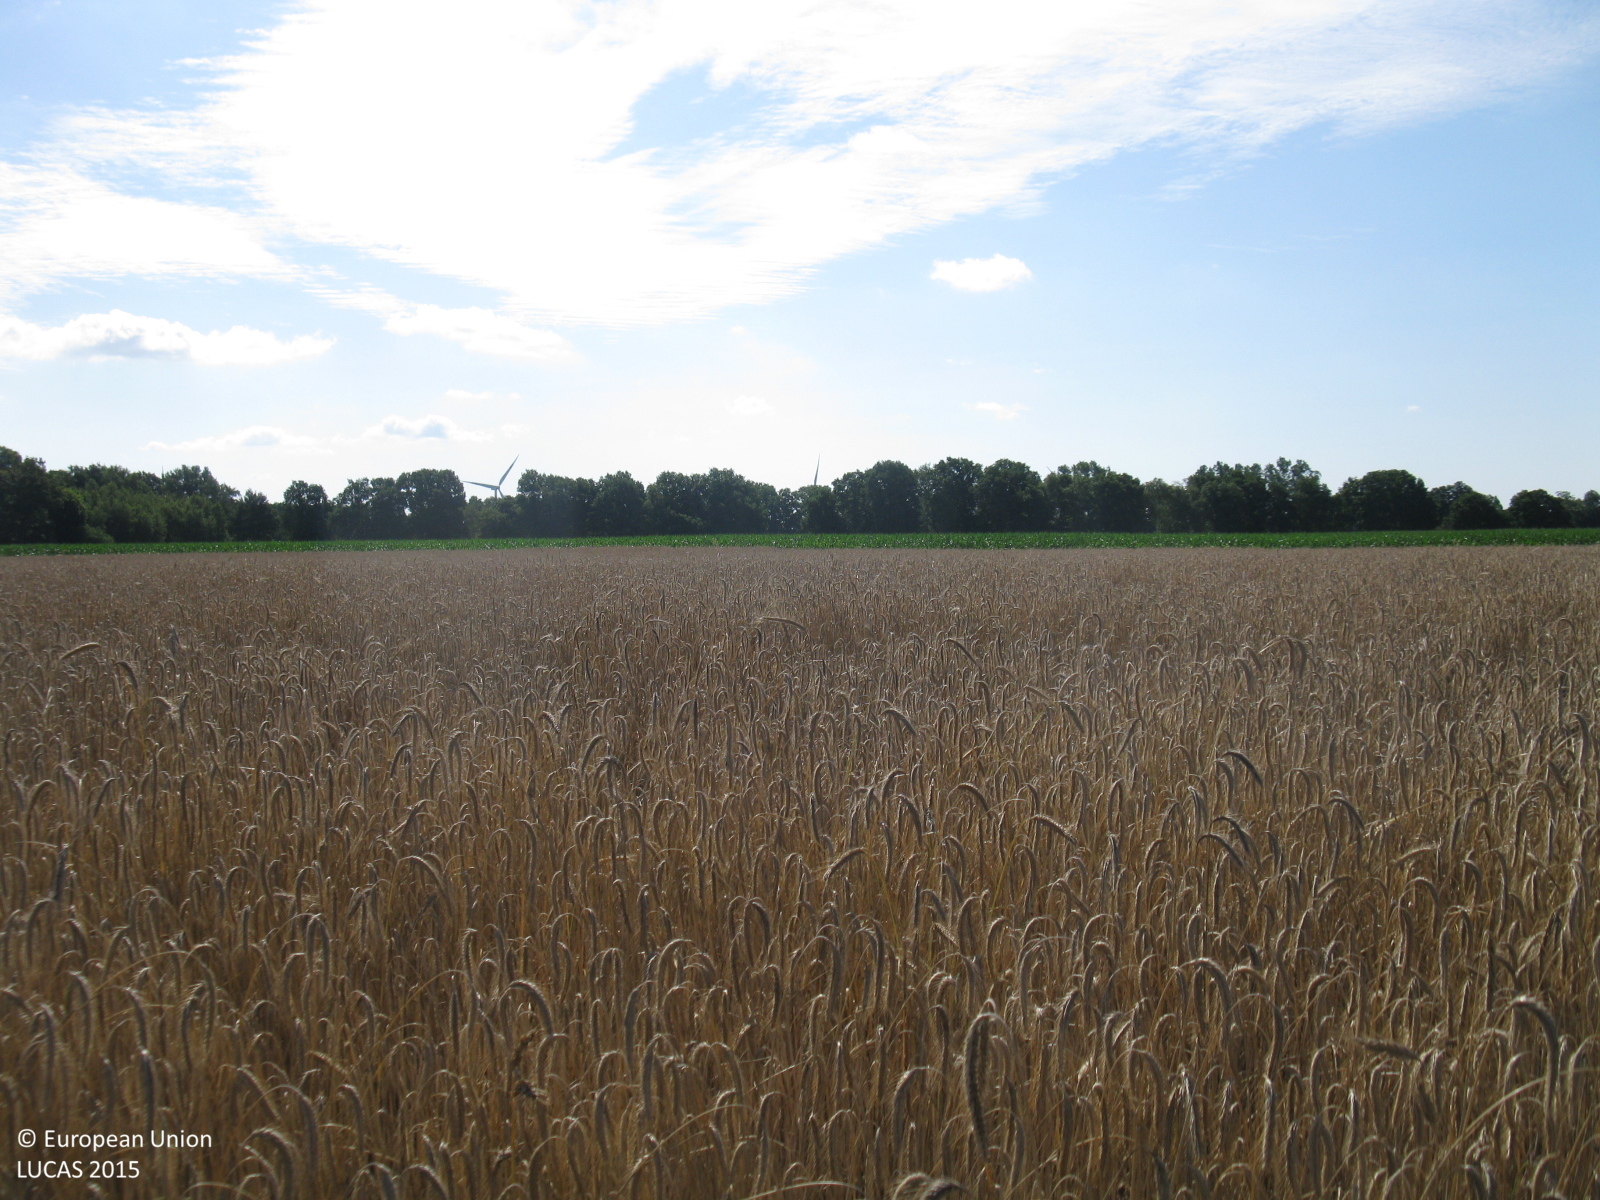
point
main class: Cropland
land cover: Triticale
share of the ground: > 75 %
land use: Agriculture (excluding fallow land and kitchen gardens)
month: July
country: DE
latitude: 52.9882
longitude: 7.9002
